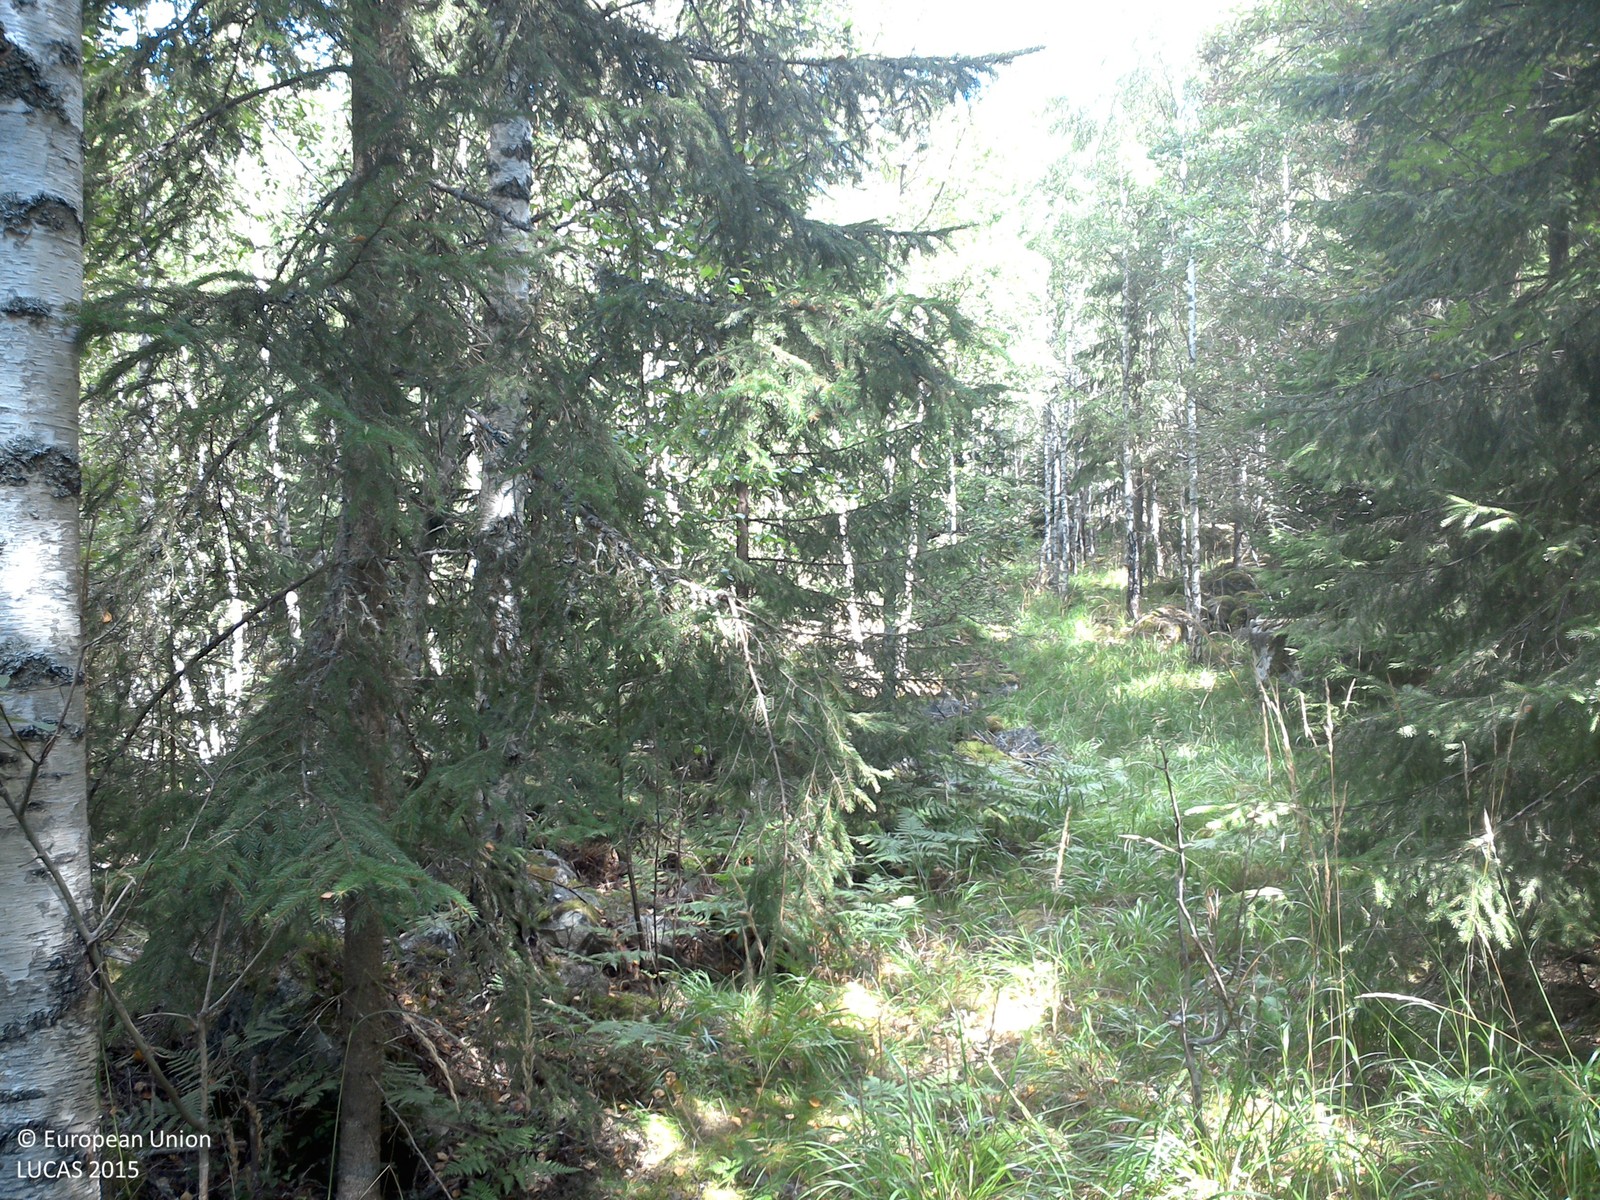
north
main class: Woodland
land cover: Spruce dominated mixed woodland
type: boreal forest
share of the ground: > 75 %
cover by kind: coniferous forest trees 45 %, herbaceous plants 25 %, broadleaved forest trees 20 %, shrubs 5 %, lichens and mosses 5 %
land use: Forestry
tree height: > 5 m
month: August
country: SE
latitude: 58.0789
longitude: 15.3025
